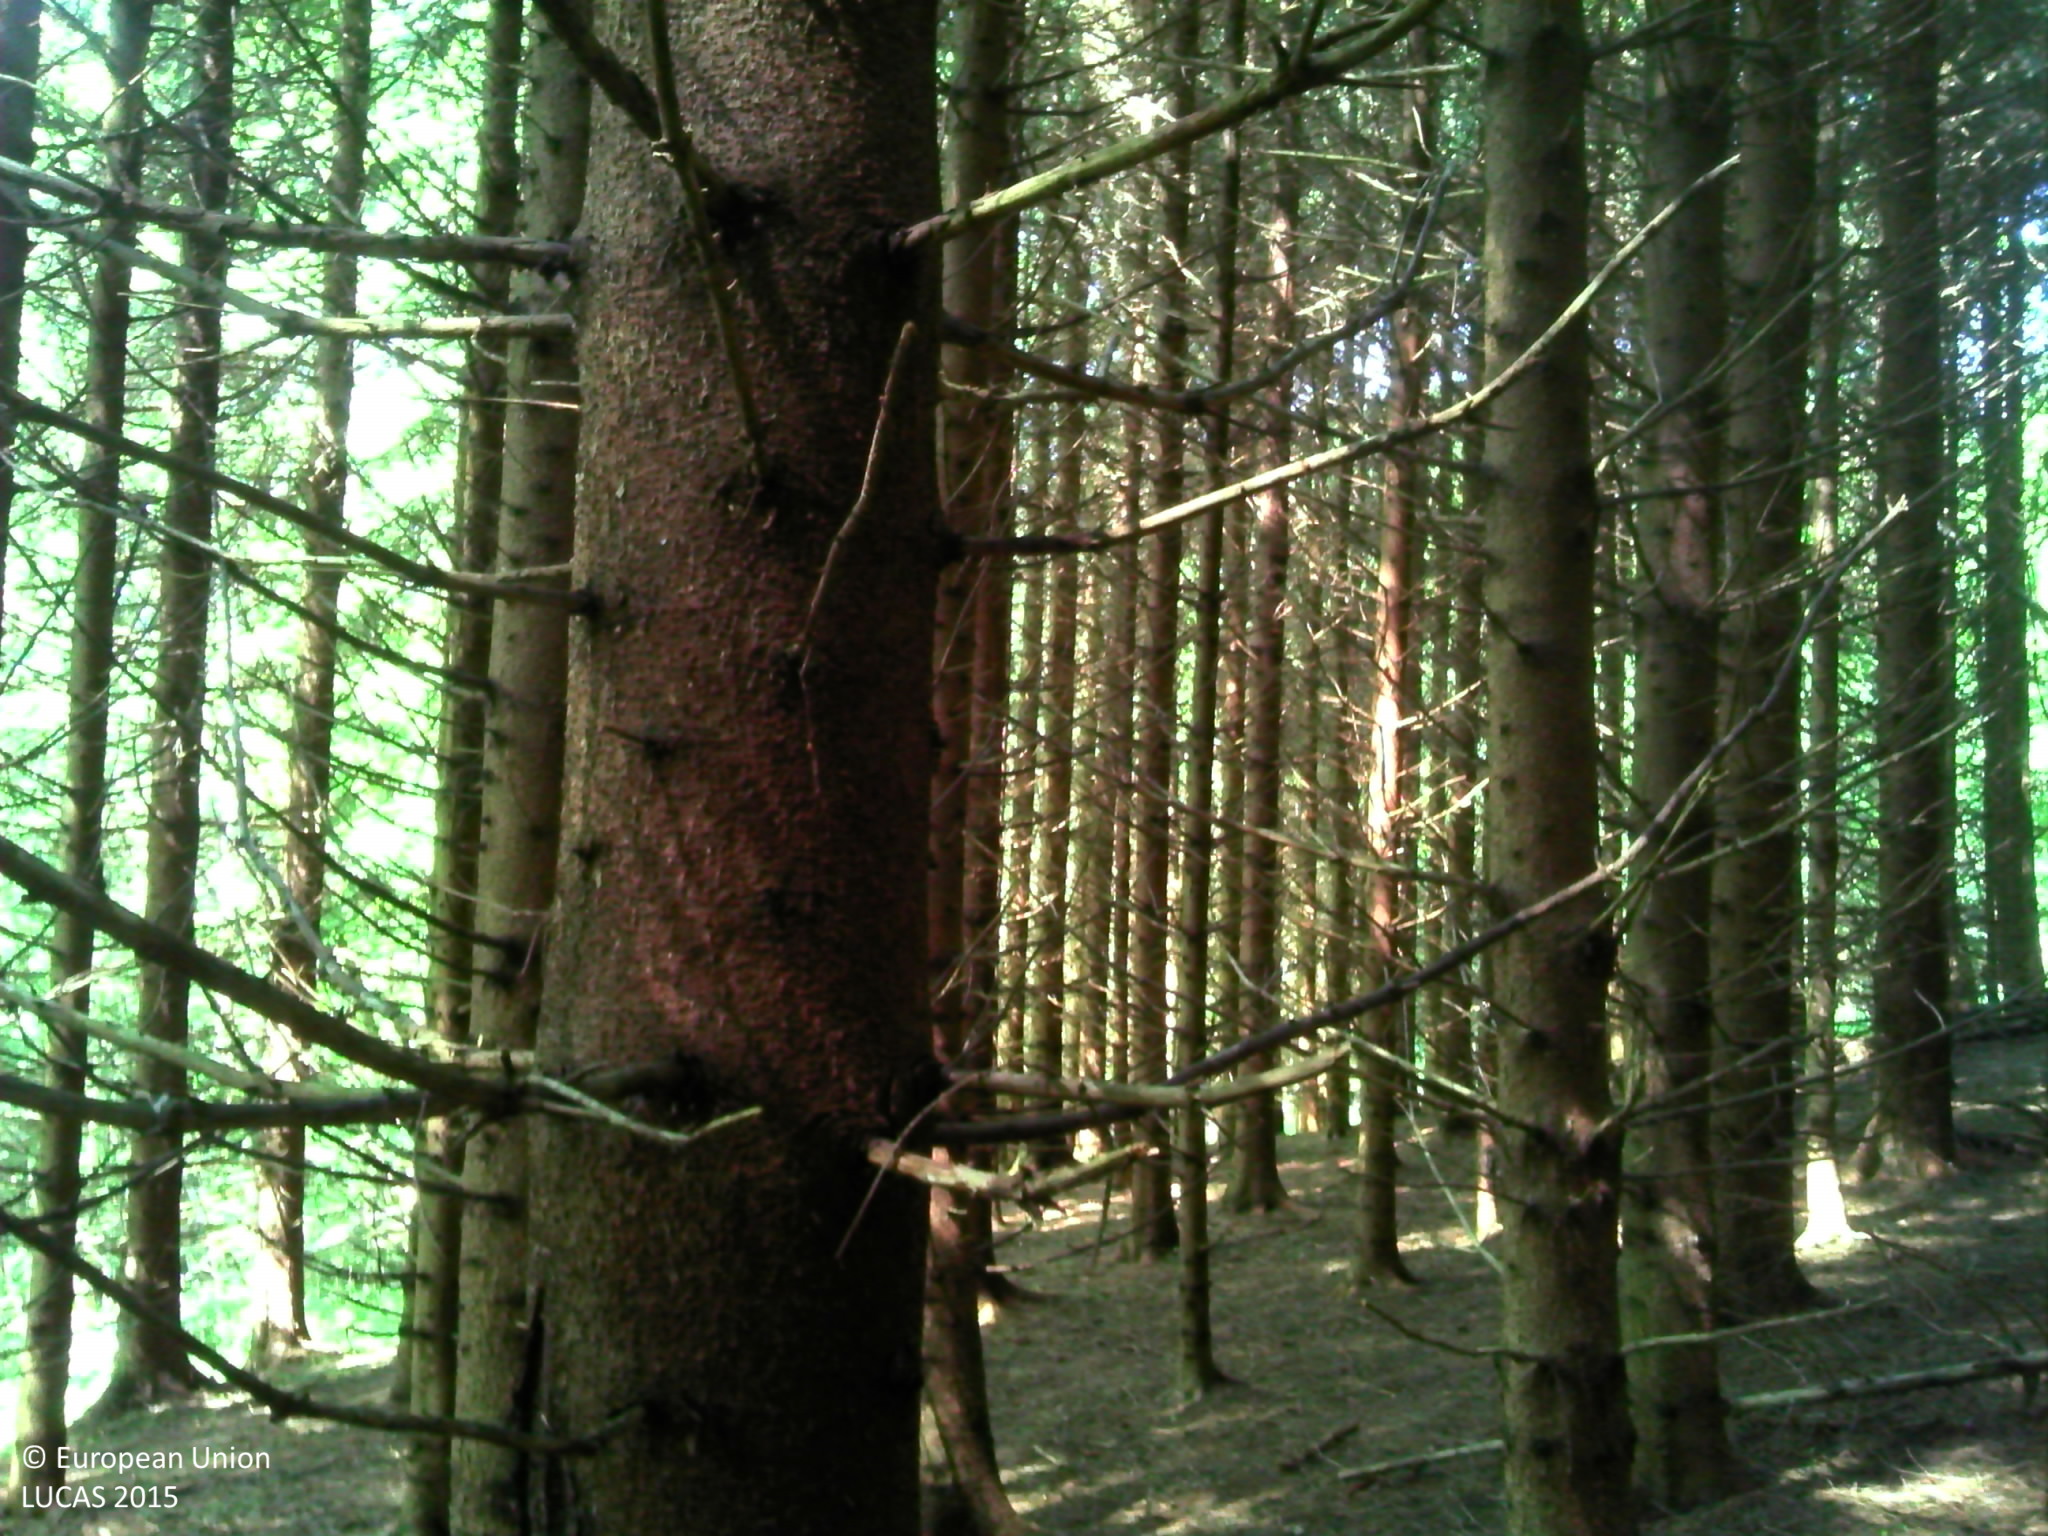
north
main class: Woodland
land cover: Spruce dominated coniferous woodland
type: alpine coniferous forest
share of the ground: > 75 %
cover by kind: coniferous forest trees 100 %
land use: Forestry
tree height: > 5 m
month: June
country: FR
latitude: 45.4894
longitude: 6.1789
